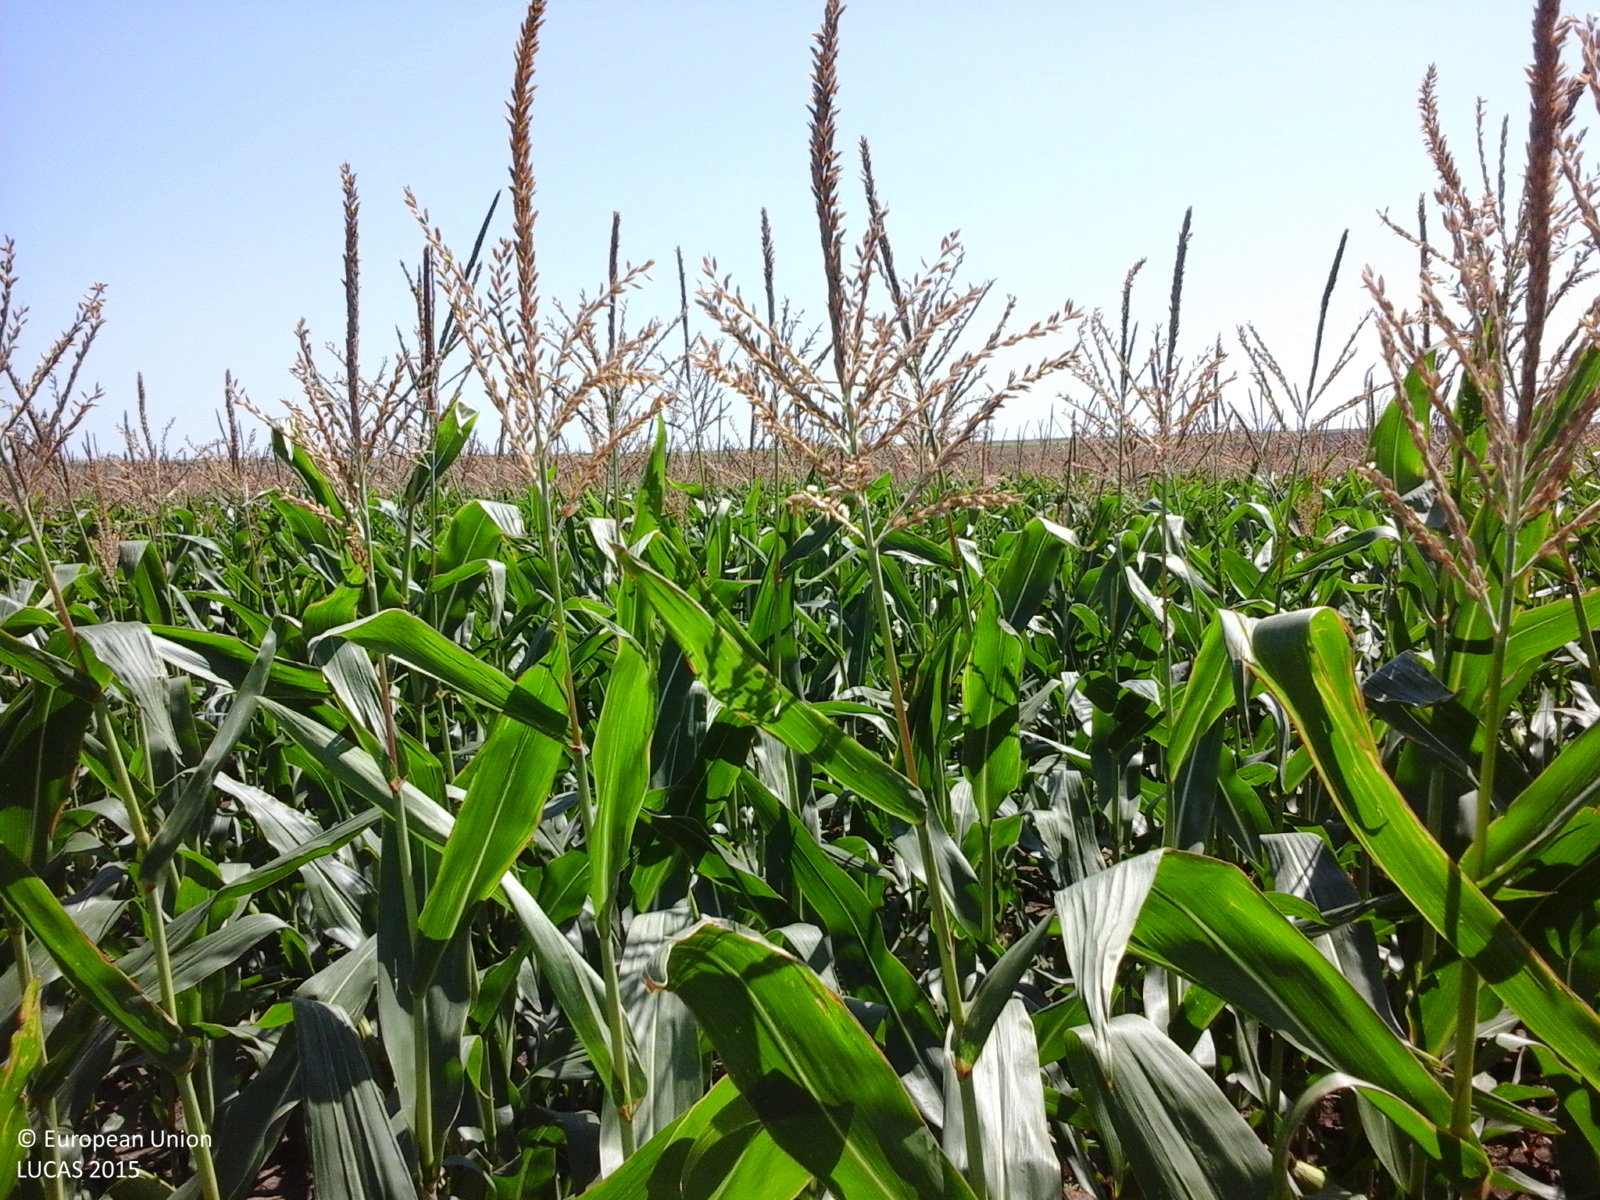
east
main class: Cropland
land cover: Maize
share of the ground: > 75 %
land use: Agriculture (excluding fallow land and kitchen gardens)
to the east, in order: Maize; Other bare soil; Common wheat
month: August
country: RO
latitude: 44.3499
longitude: 28.3962
